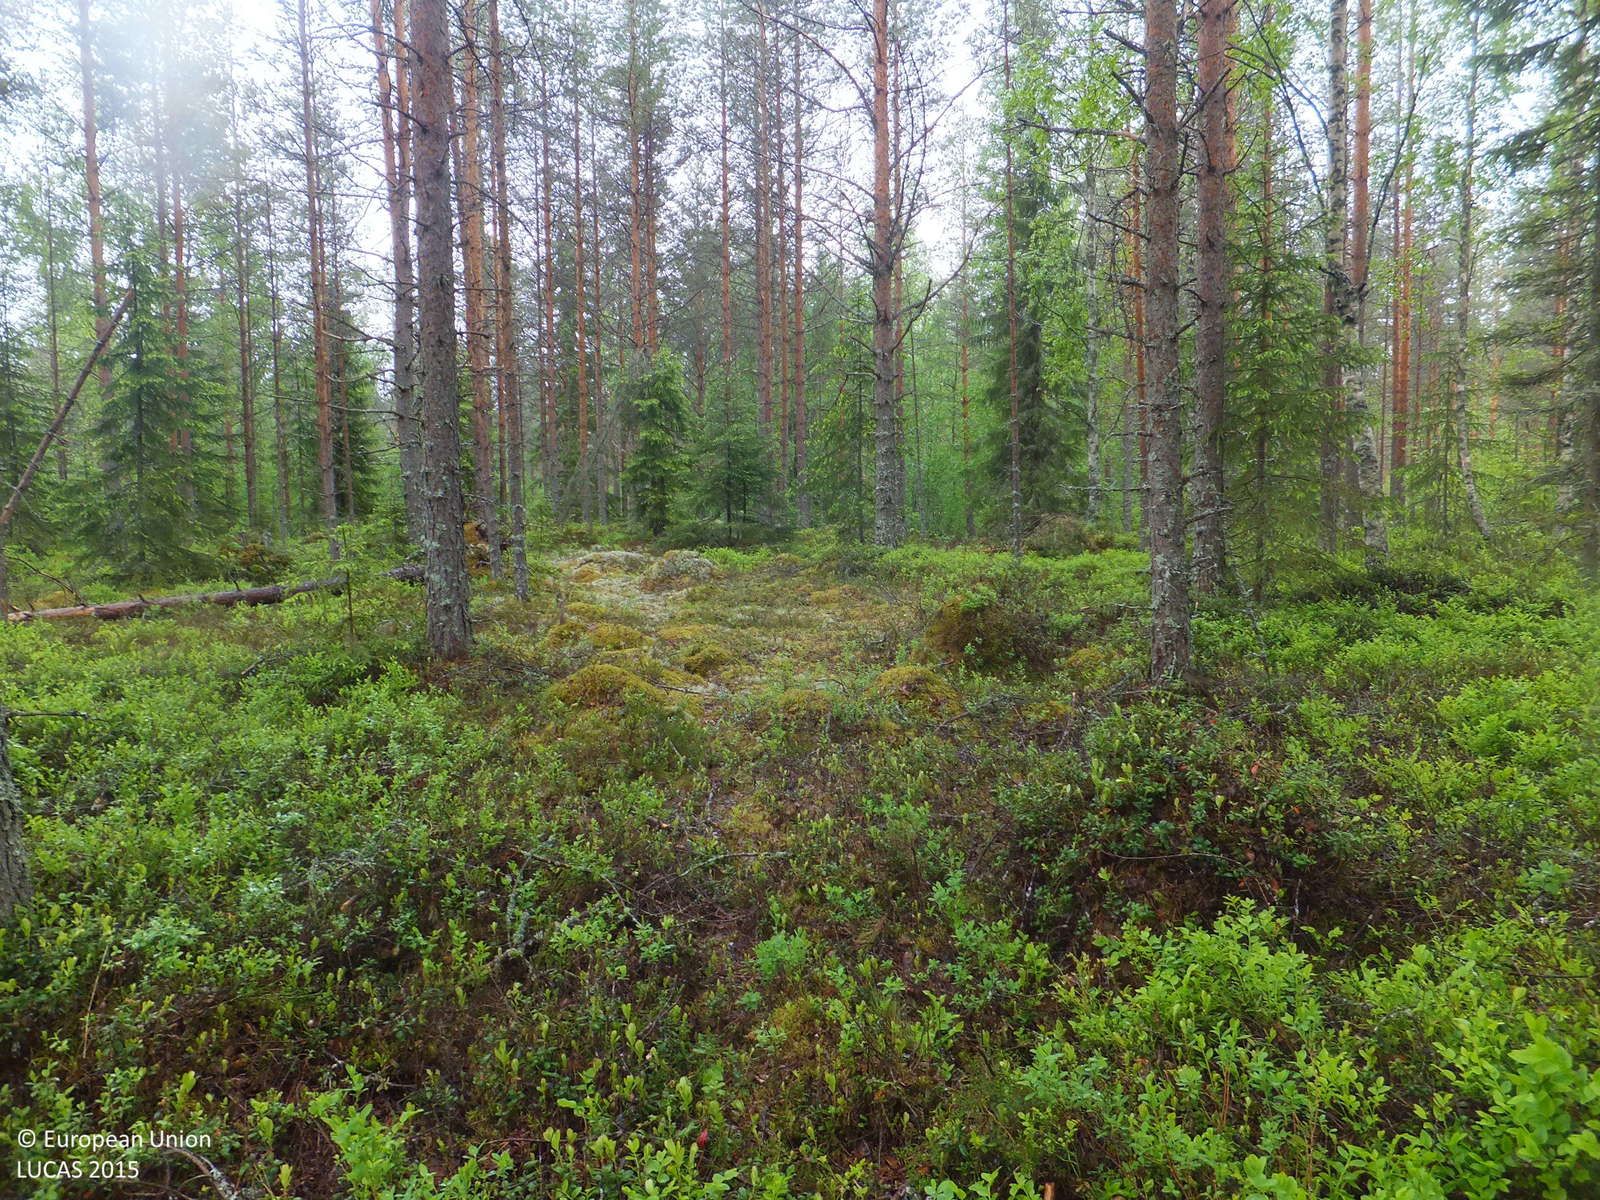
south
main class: Woodland
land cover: Pine dominated coniferous woodland
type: boreal forest
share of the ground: > 75 %
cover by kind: coniferous forest trees 80 %, shrubs 15 %, broadleaved forest trees 5 %
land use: Forestry
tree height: > 5 m
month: June
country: FI
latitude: 63.7135
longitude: 24.8387
